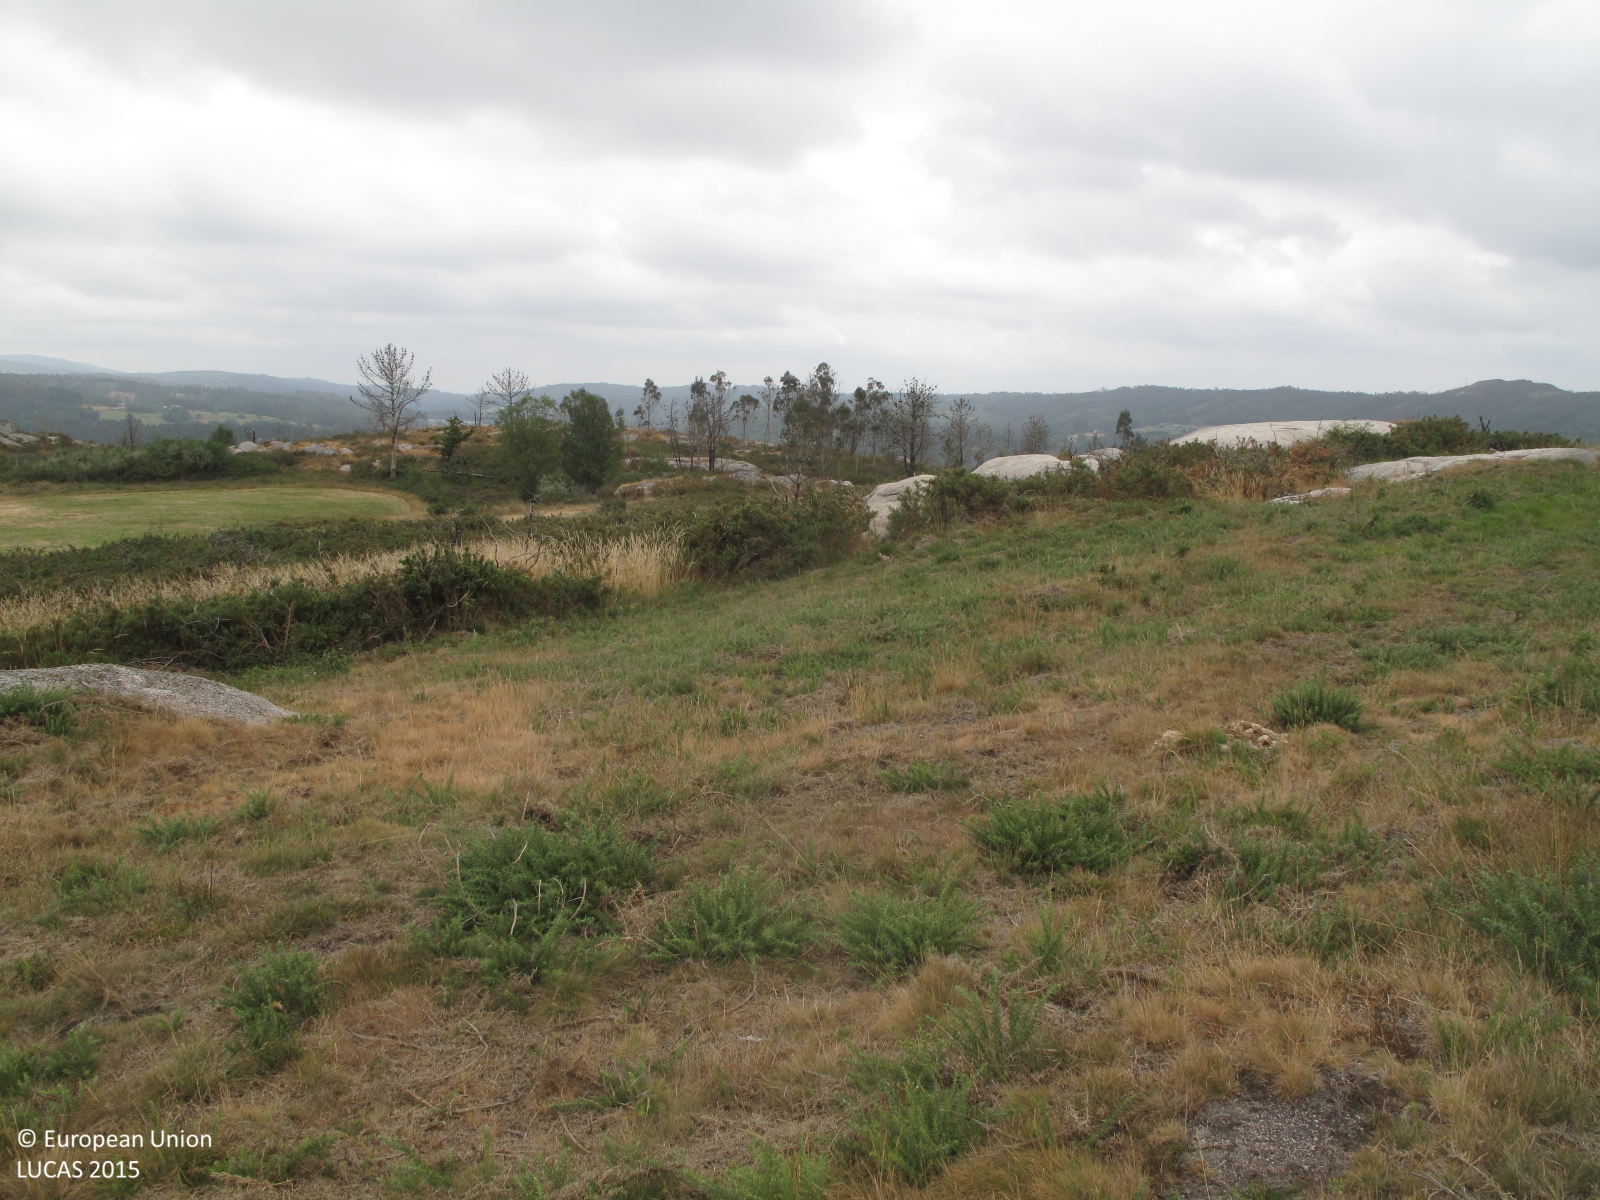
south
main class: Shrubland
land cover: Shrubland with sparse tree cover
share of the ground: > 75 %
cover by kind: shrubs 90 %, broadleaved forest trees 5 %, herbaceous plants 5 %
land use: Abandoned areas
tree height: < 5 m
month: July
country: ES
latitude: 43.4171
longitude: -8.0417
